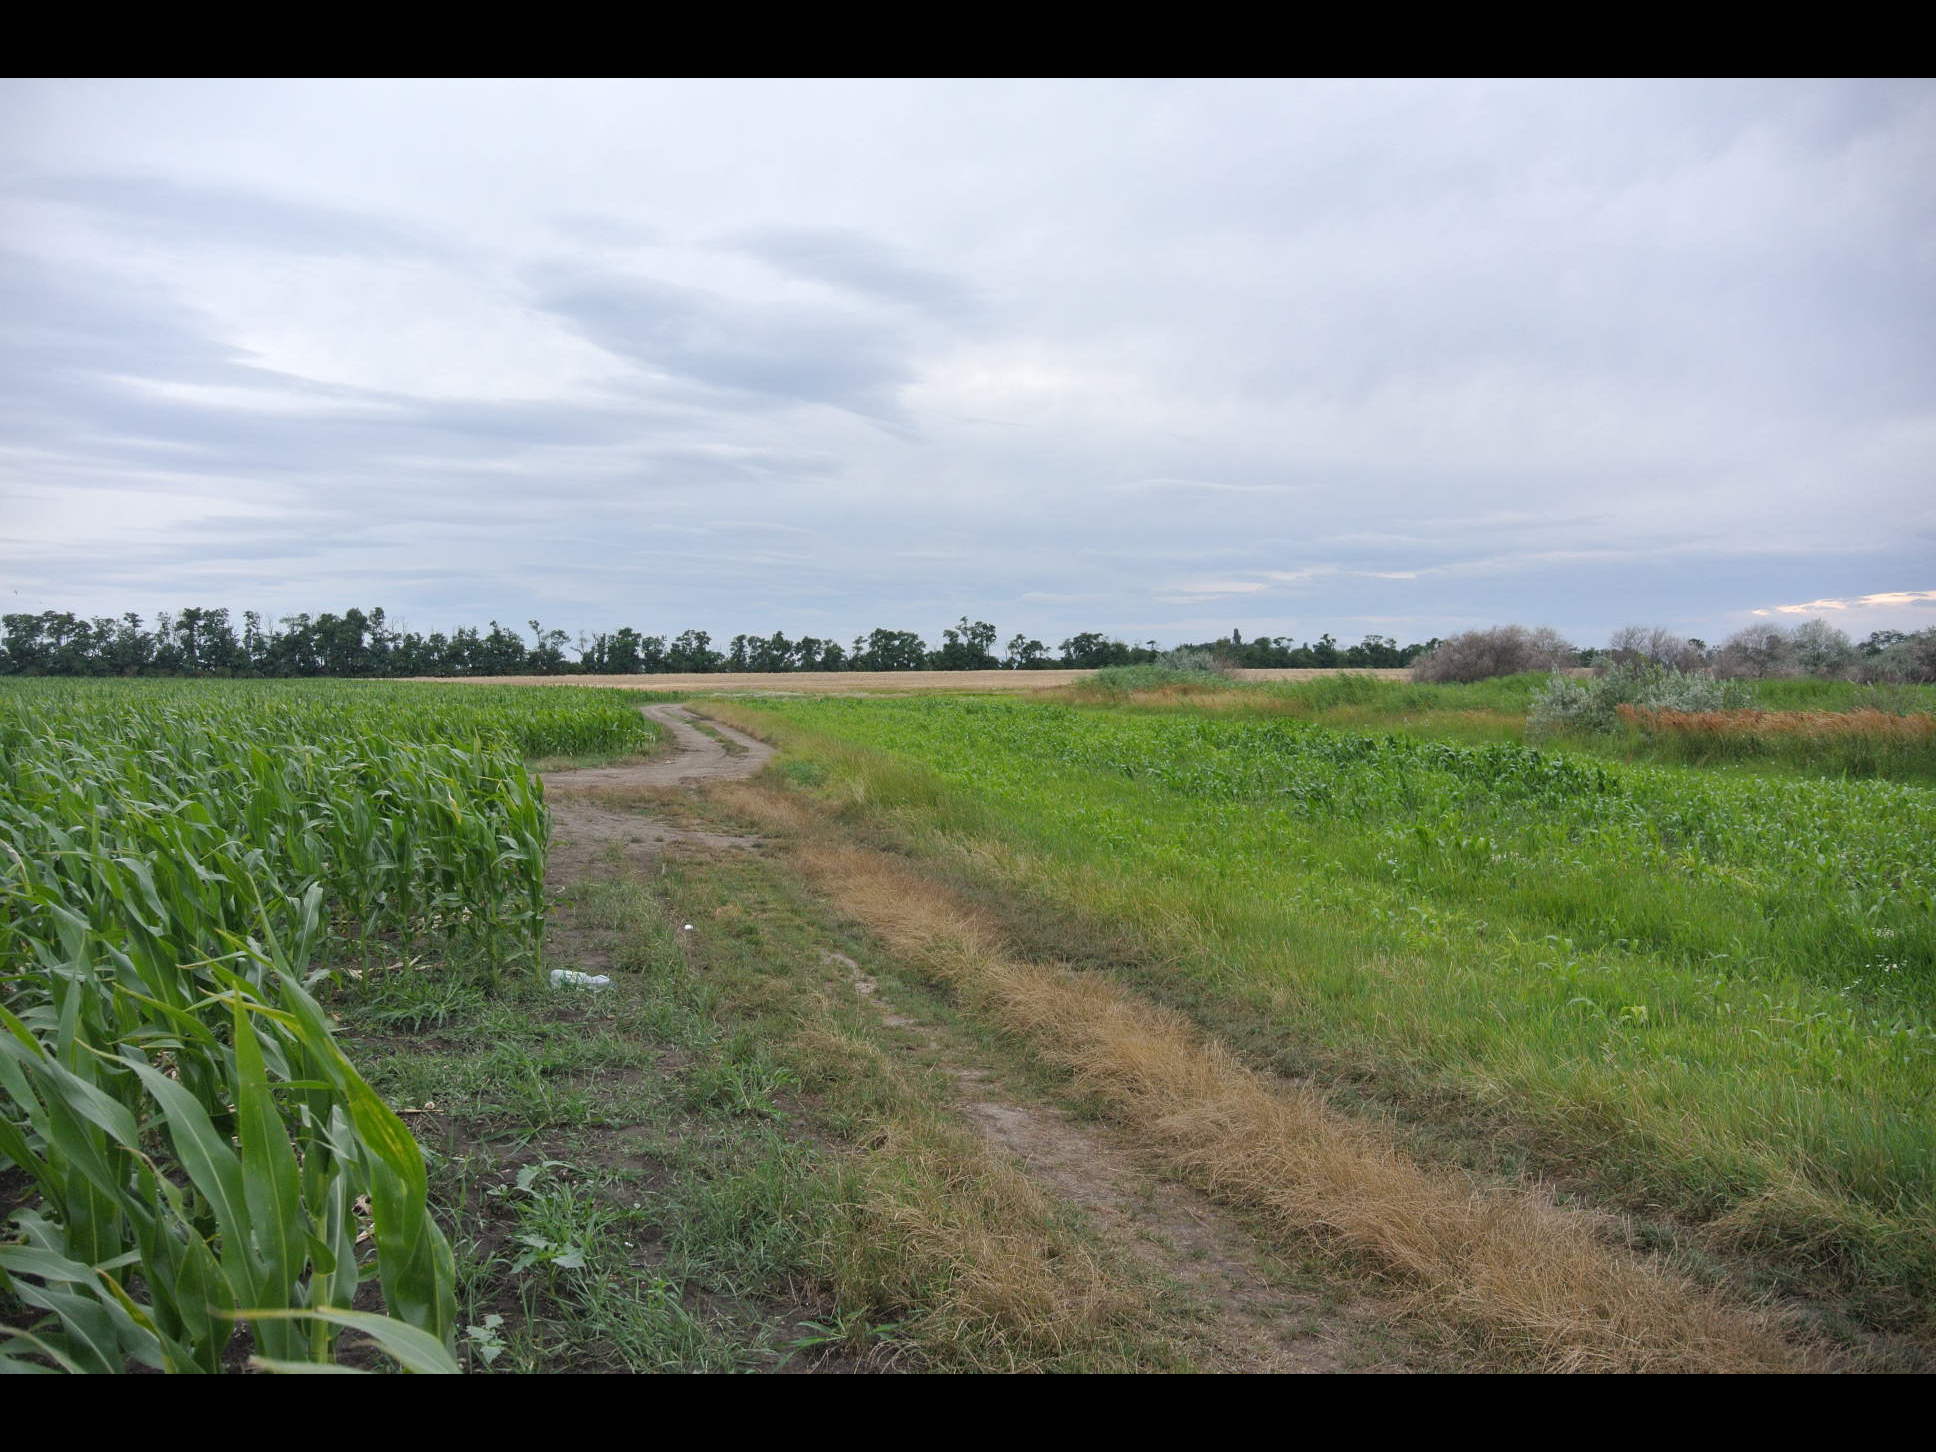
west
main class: Cropland
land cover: Maize
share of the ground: > 75 %
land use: Agriculture (excluding fallow land and kitchen gardens)
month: July
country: AT
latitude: 47.7918
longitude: 16.8808
